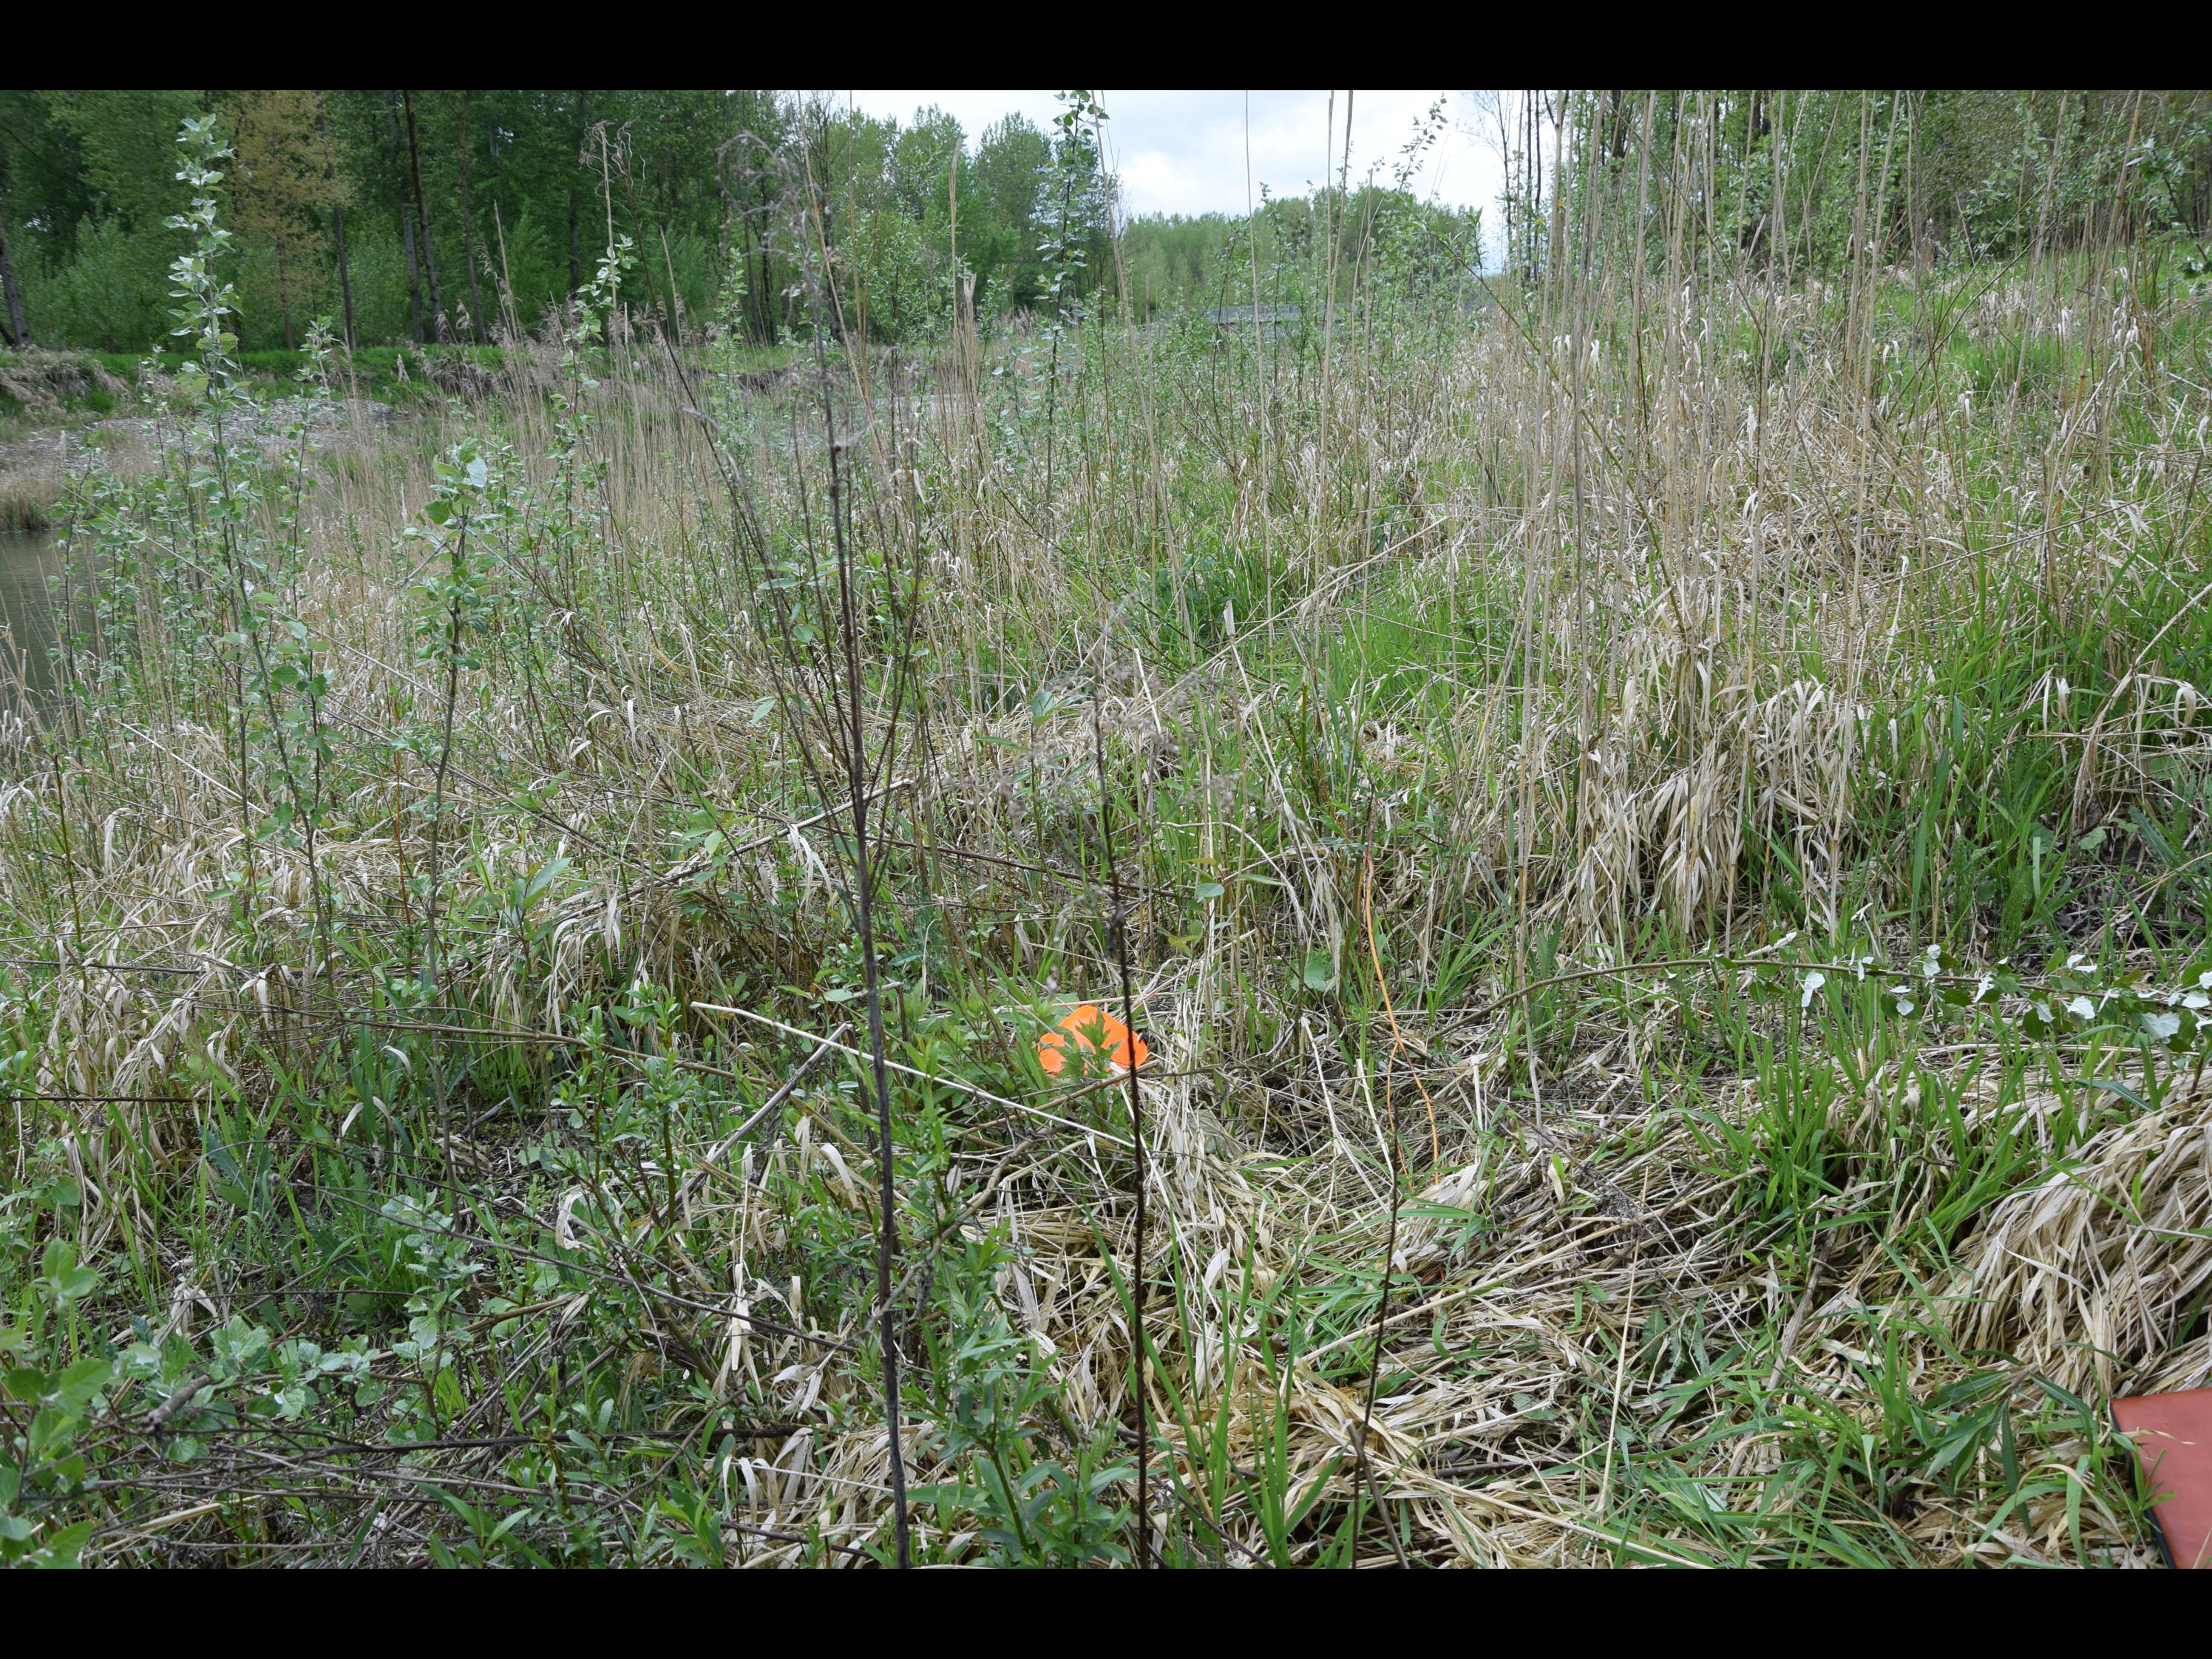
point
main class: Shrubland
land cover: Shrubland with sparse tree cover
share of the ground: > 75 %
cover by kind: herbaceous plants 80 %, shrubs 15 %, broadleaved forest trees 5 %
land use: Semi-natural and natural areas not in use
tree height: < 5 m
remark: Temporary flooded
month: May
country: AT
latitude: 48.1990
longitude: 14.6153
